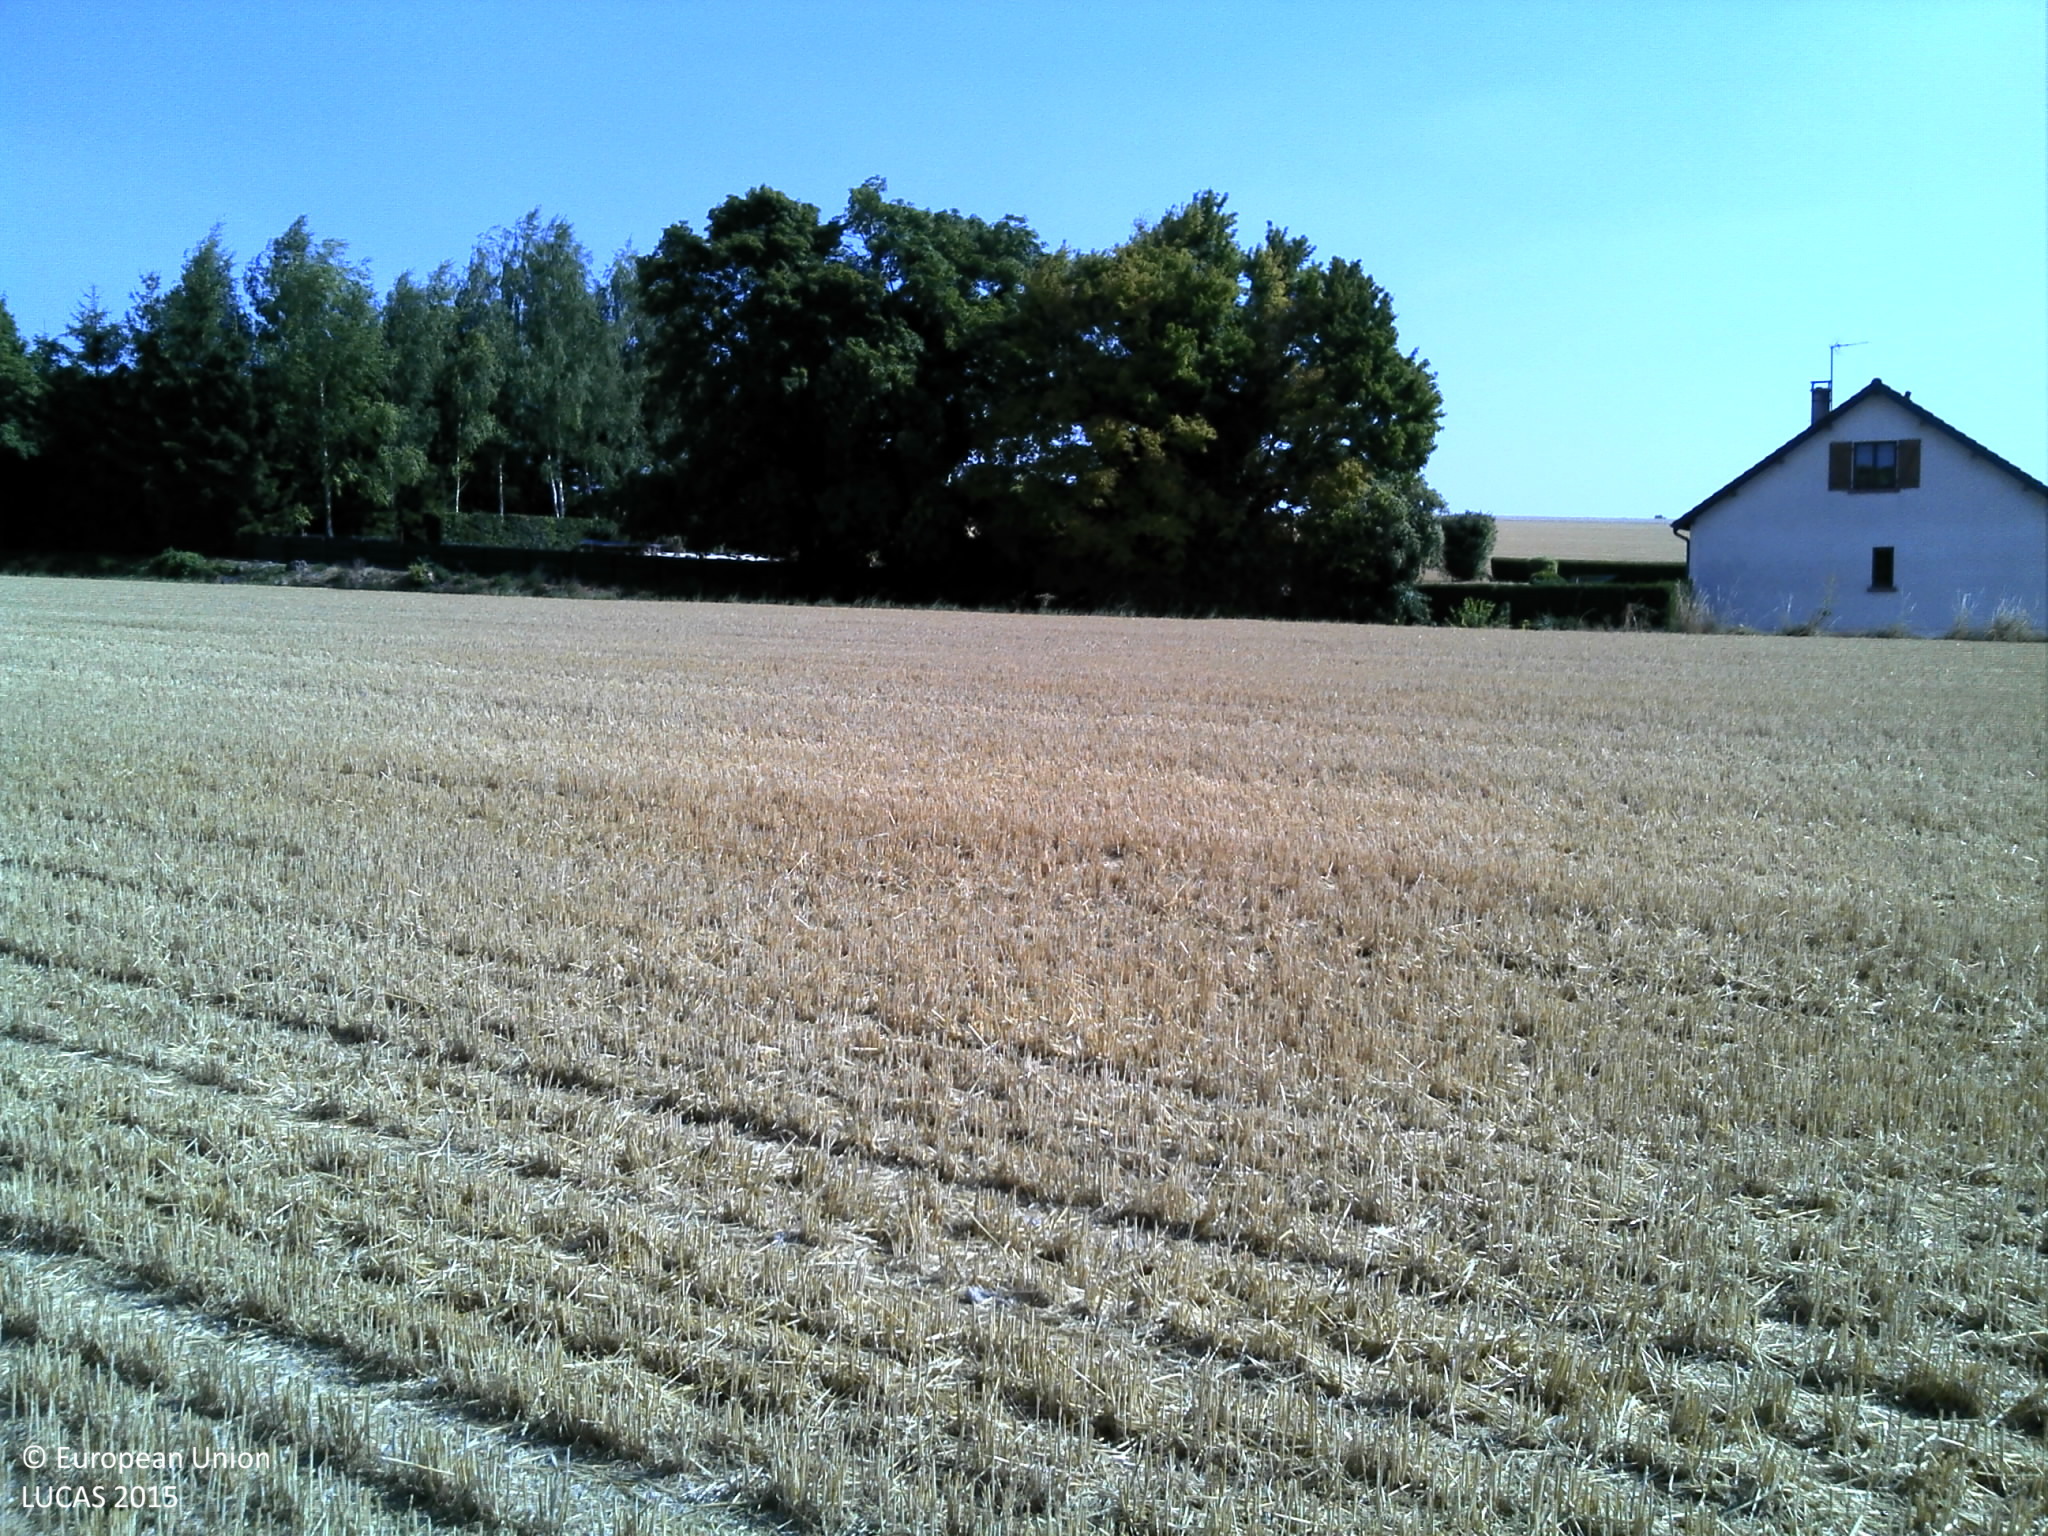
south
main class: Cropland
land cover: Barley
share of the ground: > 75 %
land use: Agriculture (excluding fallow land and kitchen gardens)
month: August
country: FR
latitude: 48.9236
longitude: 4.6608
